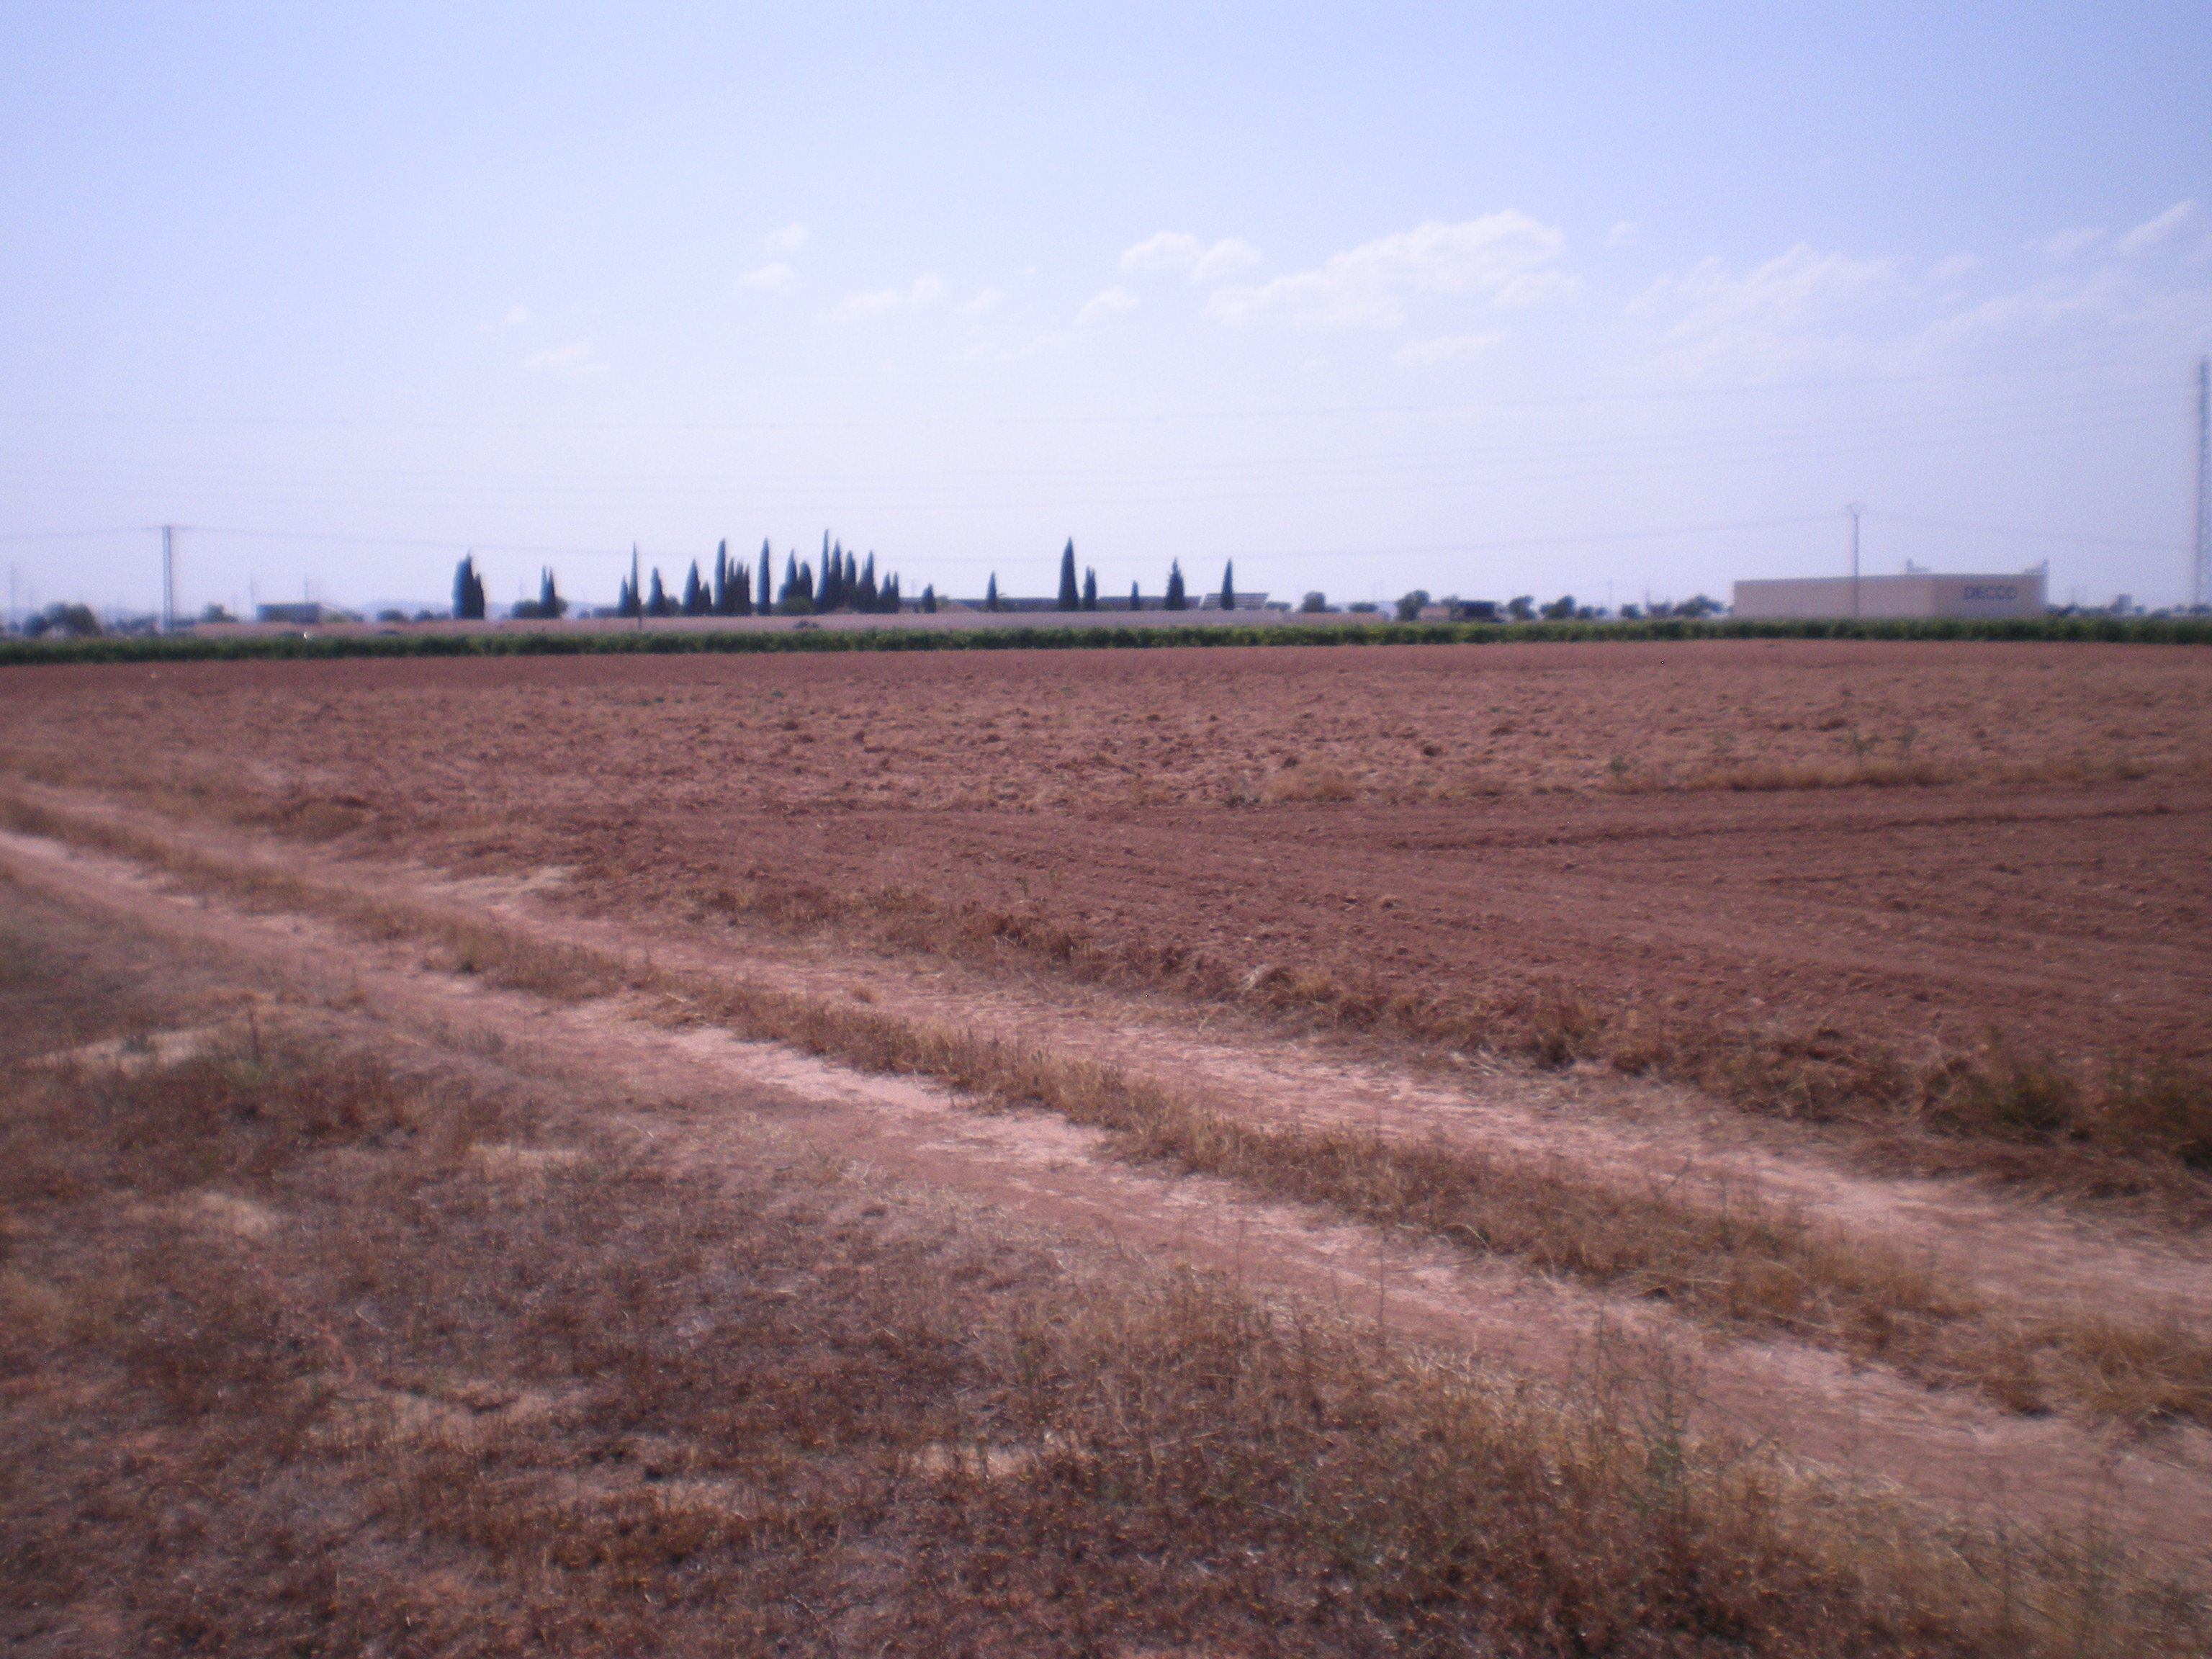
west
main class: Grassland
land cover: Spontaneously vegetated surfaces
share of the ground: 10 - 25 %
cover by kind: unconsolidated bare surface 80 %, herbaceous plants 20 %
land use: Agriculture (excluding fallow land and kitchen gardens)
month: July
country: ES
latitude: 39.4913
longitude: -3.5223
